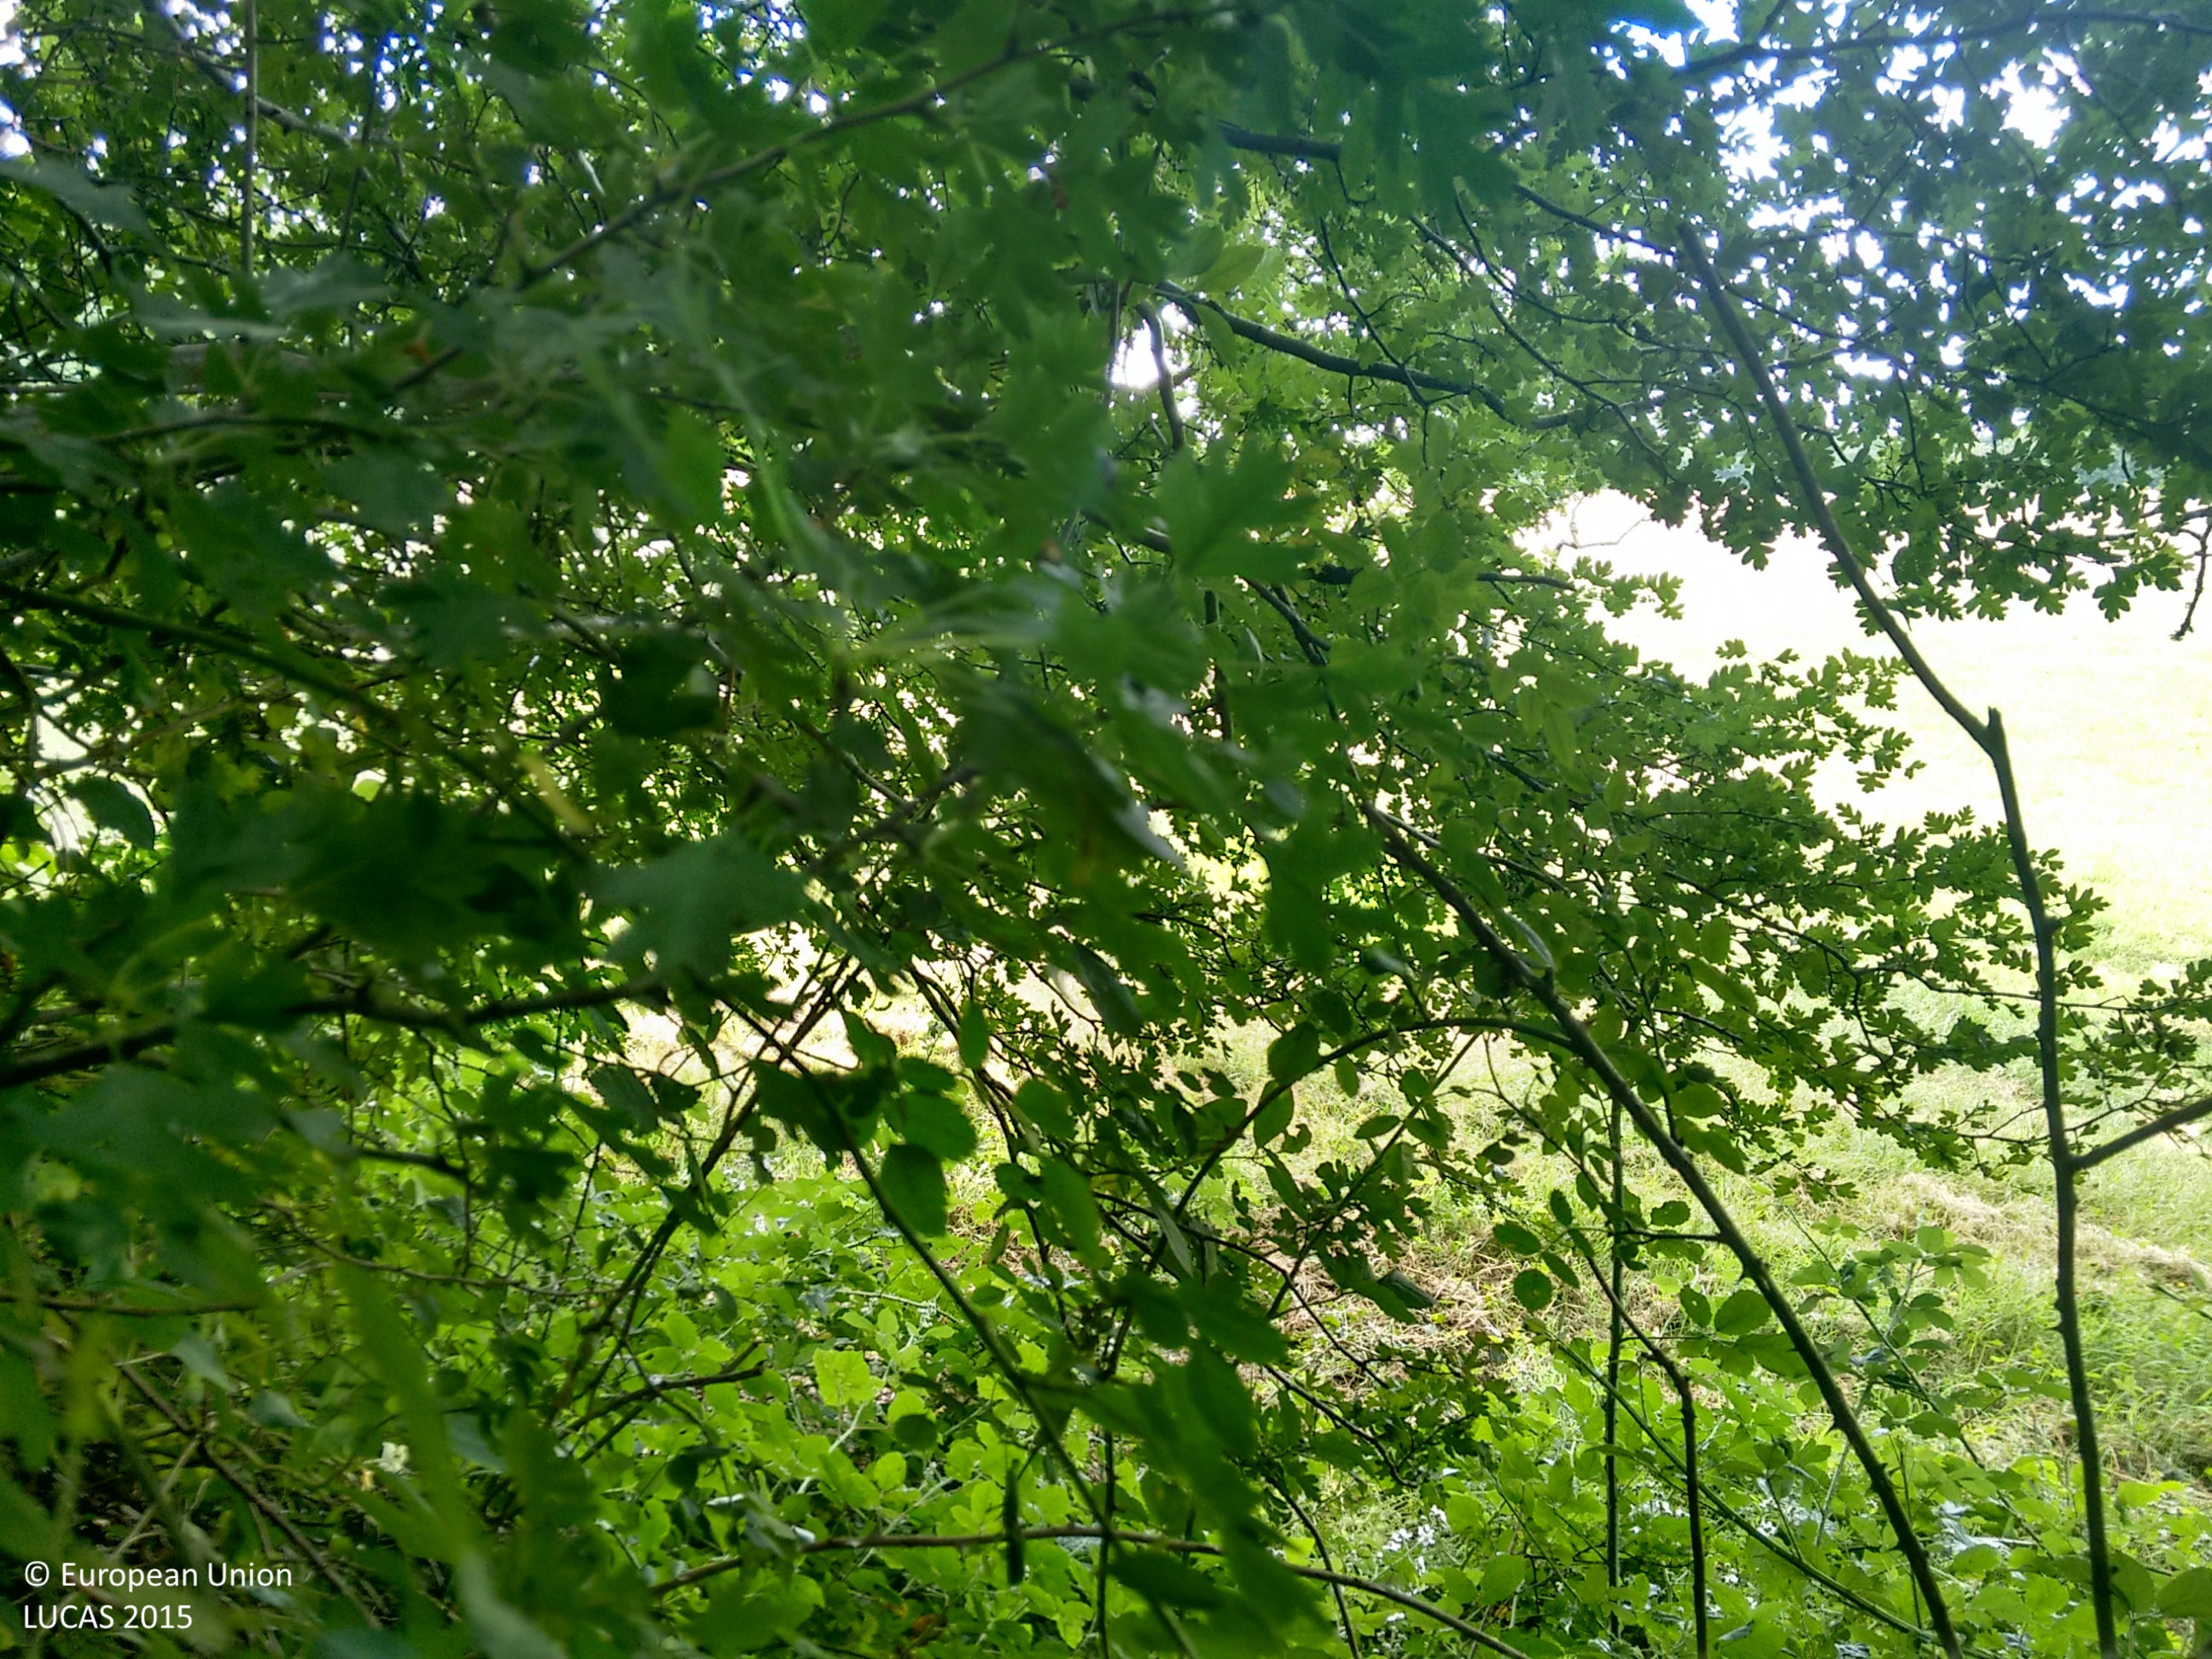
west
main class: Woodland
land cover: Broadleaved woodland
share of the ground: > 75 %
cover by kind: broadleaved forest trees 100 %
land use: Agriculture (excluding fallow land and kitchen gardens)
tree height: > 5 m
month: July
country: GB
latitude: 51.0204
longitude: -0.5166
